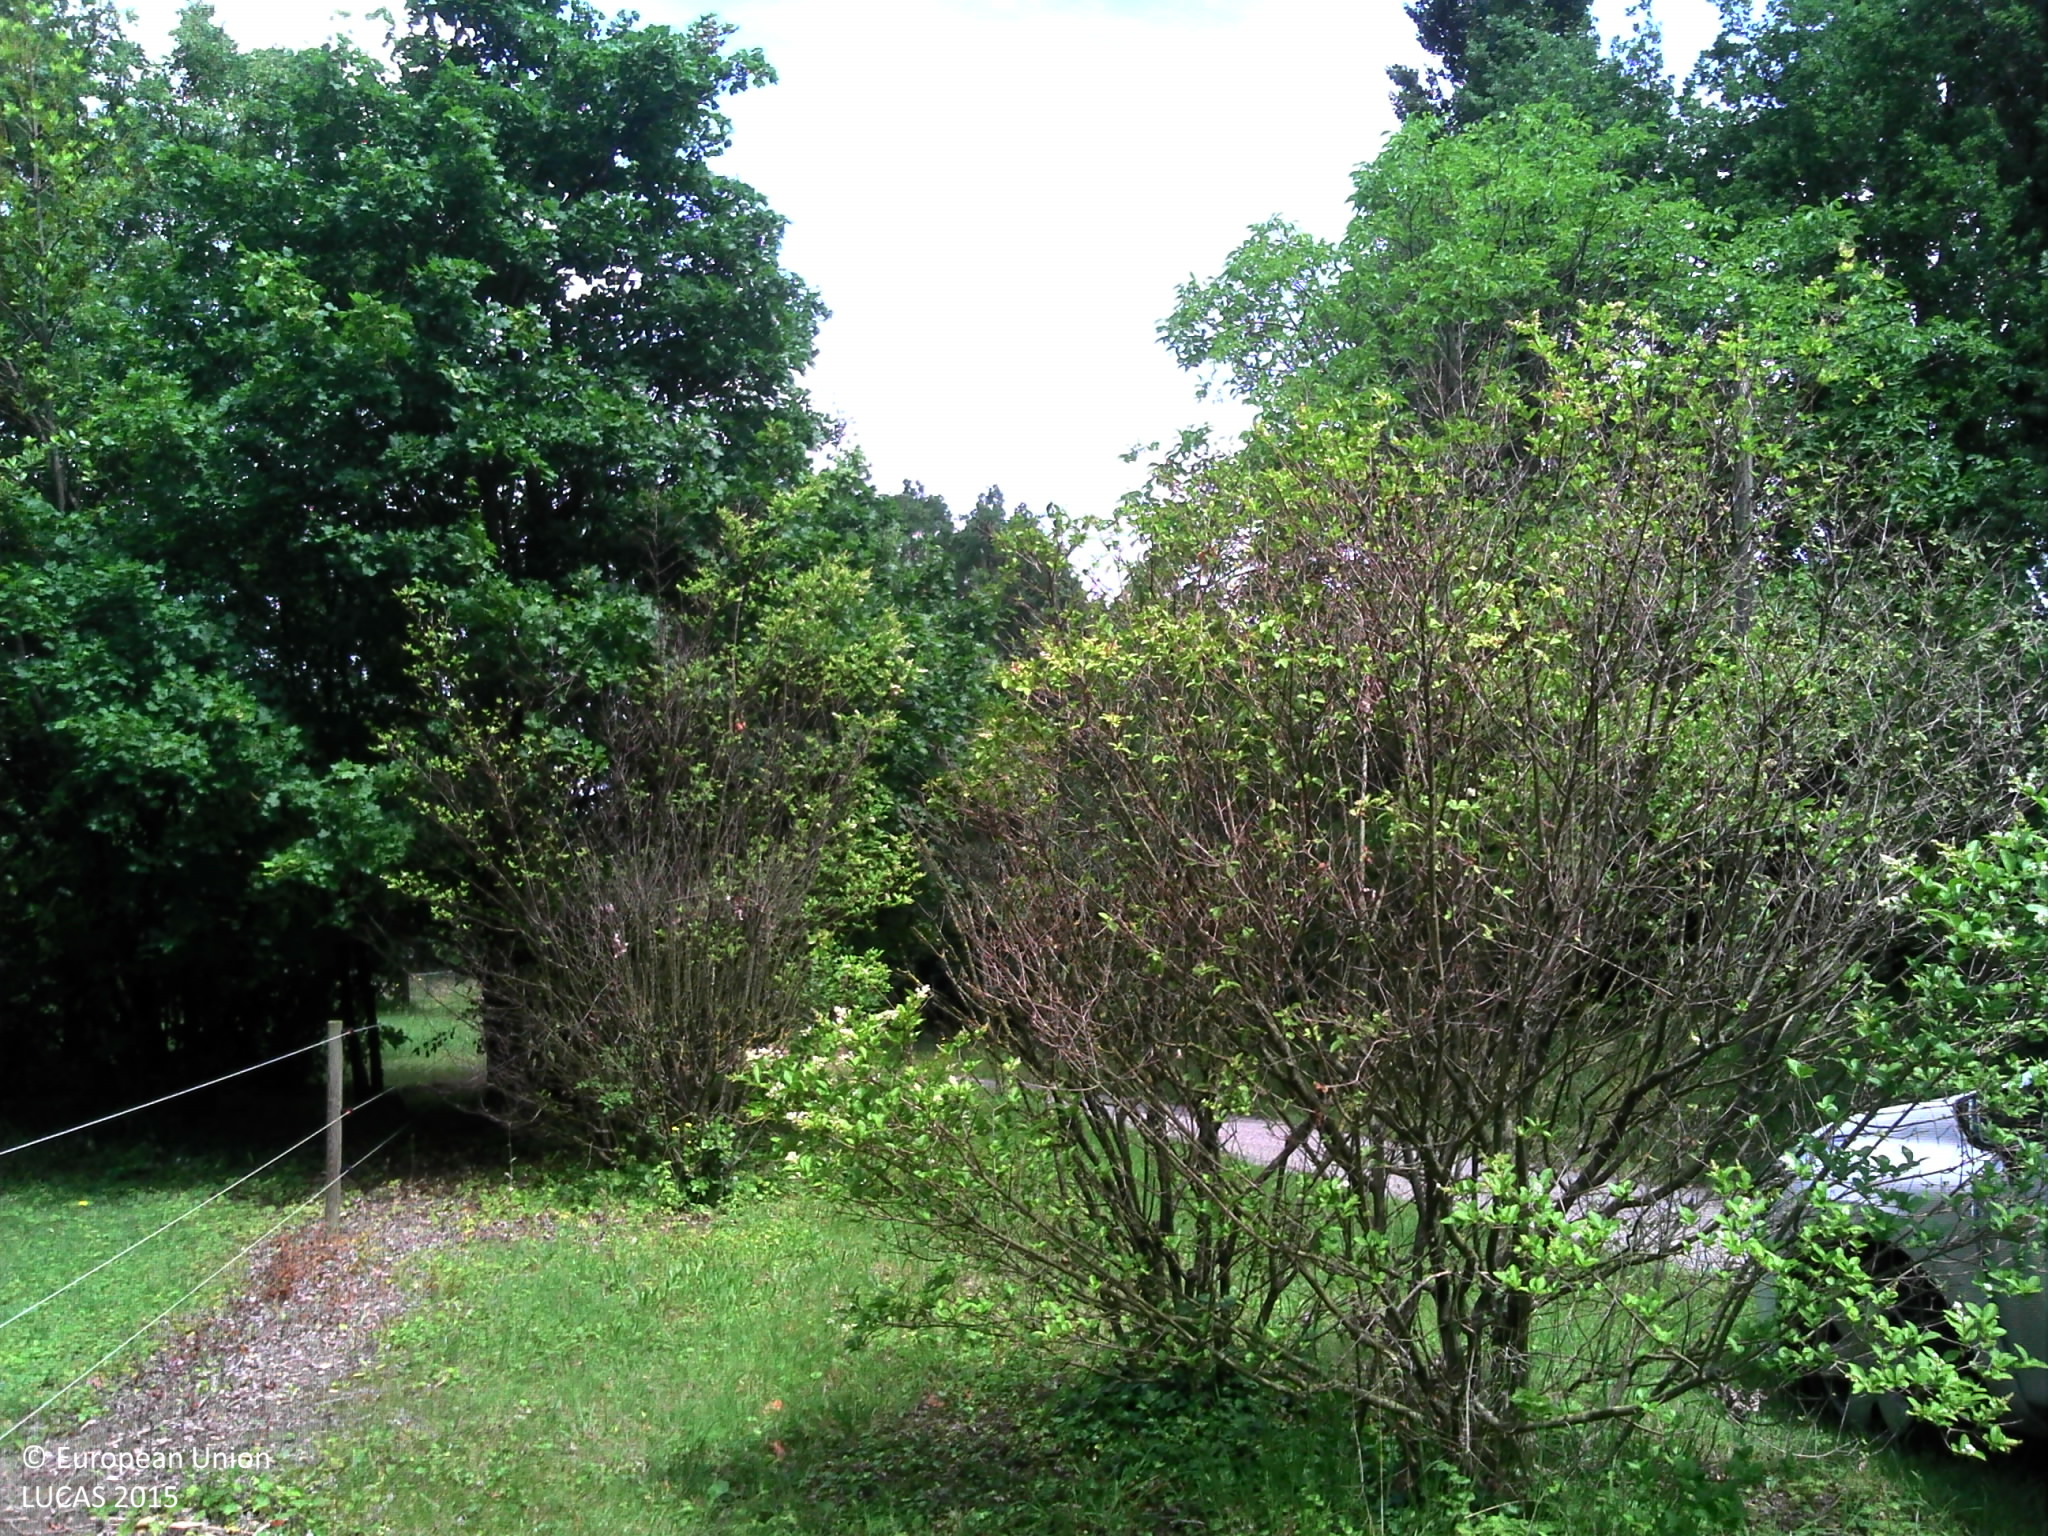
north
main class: Grassland
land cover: Grassland with sparse tree/shrub cover
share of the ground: > 75 %
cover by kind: herbaceous plants 95 %, broadleaved forest trees 5 %
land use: Residential
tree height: > 5 m
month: June
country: FR
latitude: 44.7919
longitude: 5.0386
